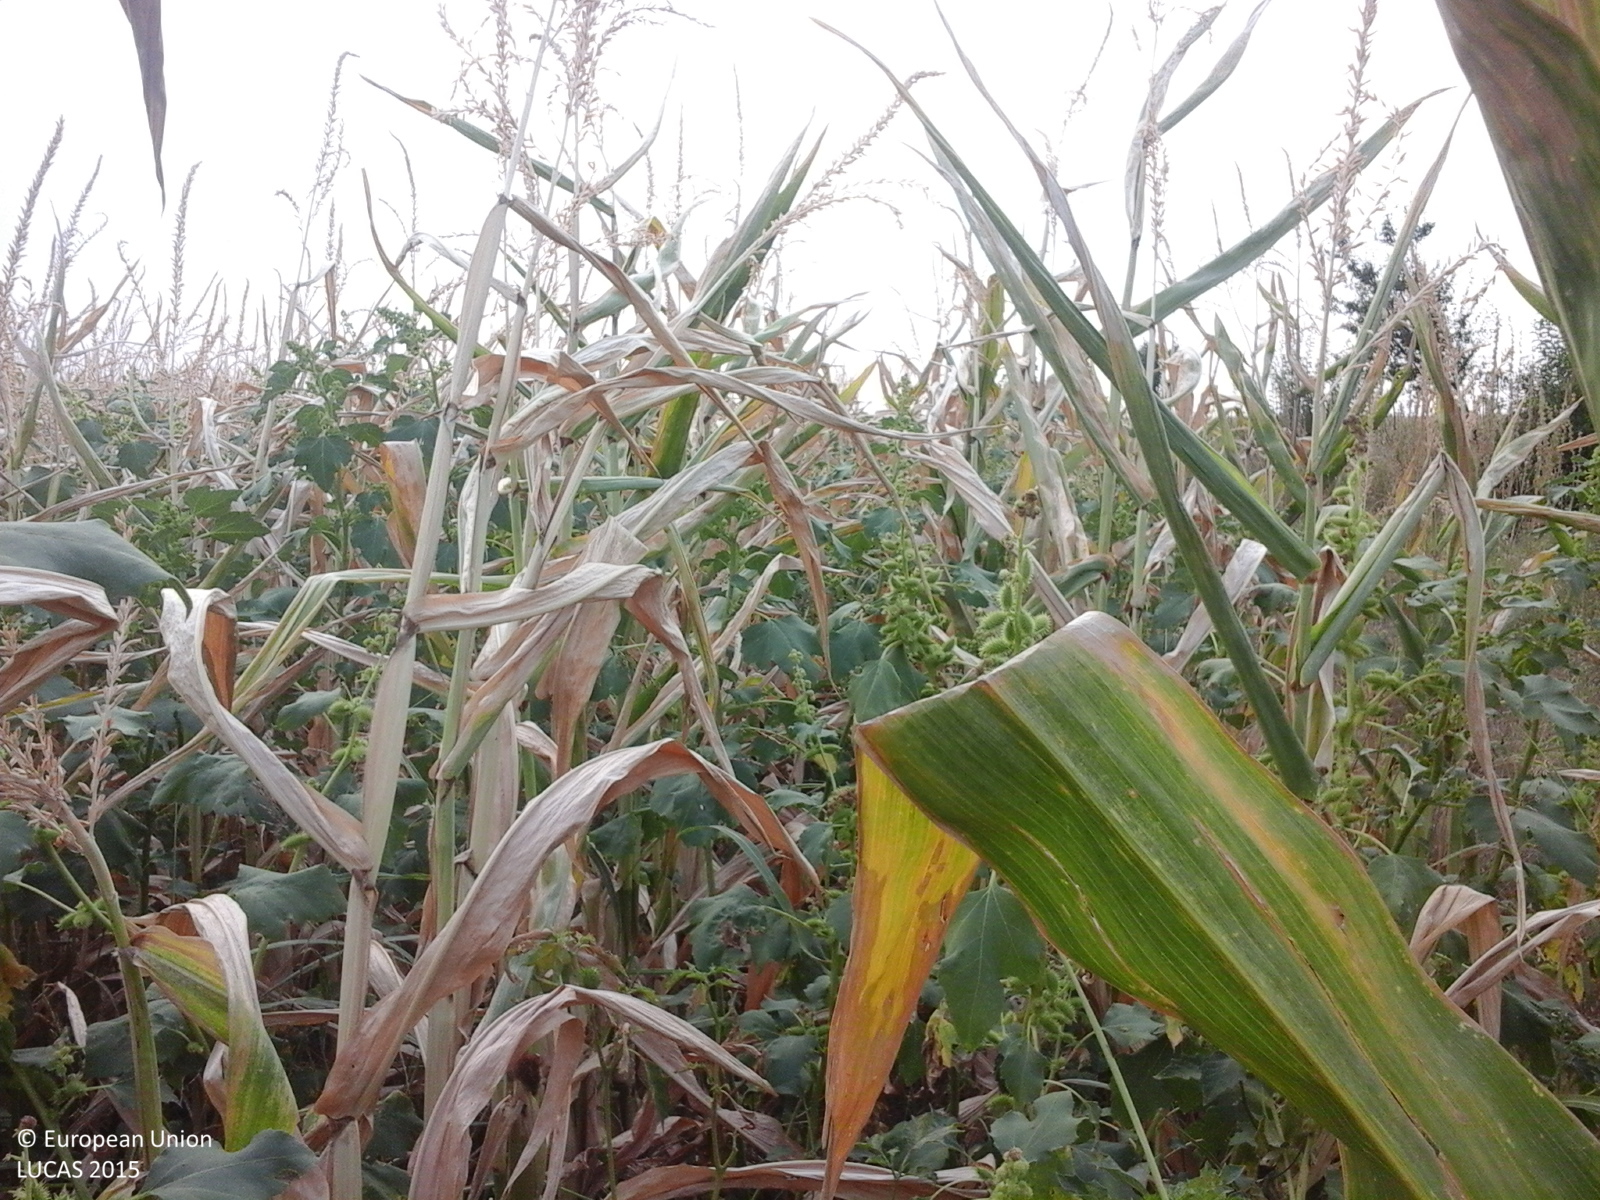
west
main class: Cropland
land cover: Maize
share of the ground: > 75 %
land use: Agriculture (excluding fallow land and kitchen gardens)
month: August
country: RO
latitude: 43.9460
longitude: 23.1634
